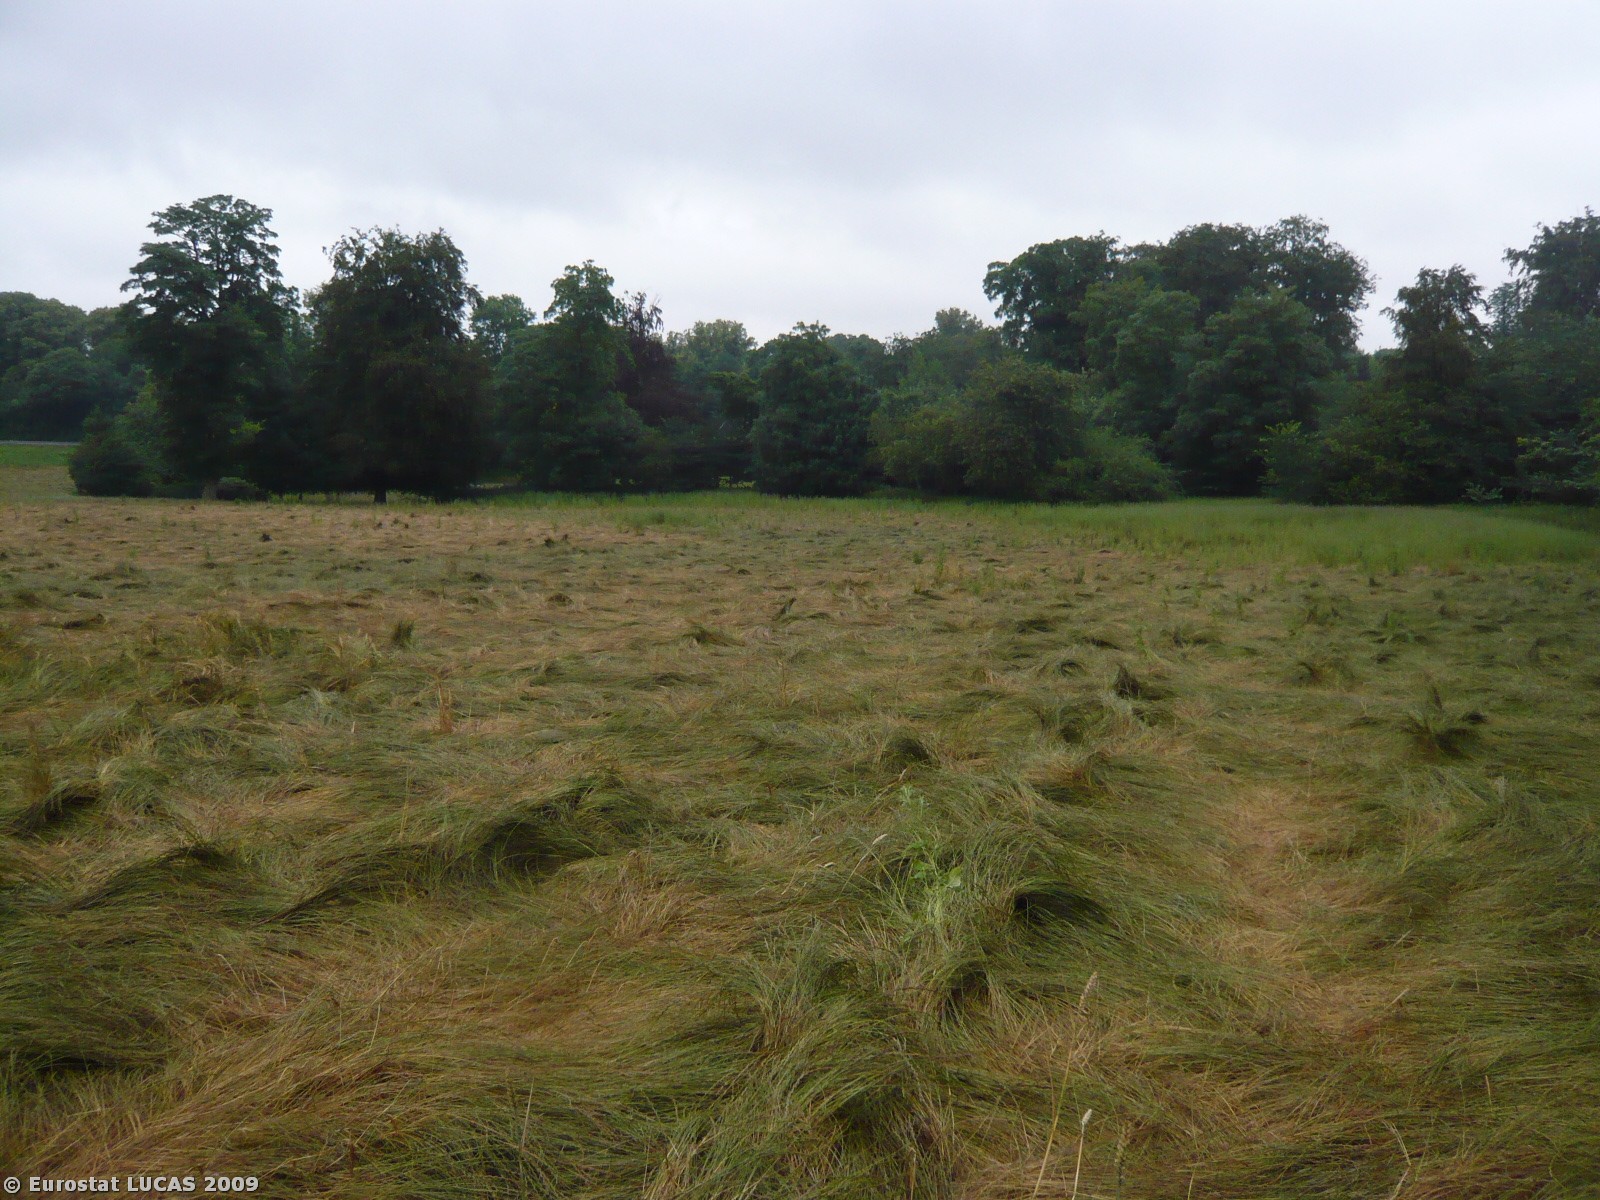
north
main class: Cropland
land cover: Temporary grasslands
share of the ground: > 75 %
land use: Agriculture (excluding fallow land and kitchen gardens)
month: July
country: DK
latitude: 55.6709
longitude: 11.8586
